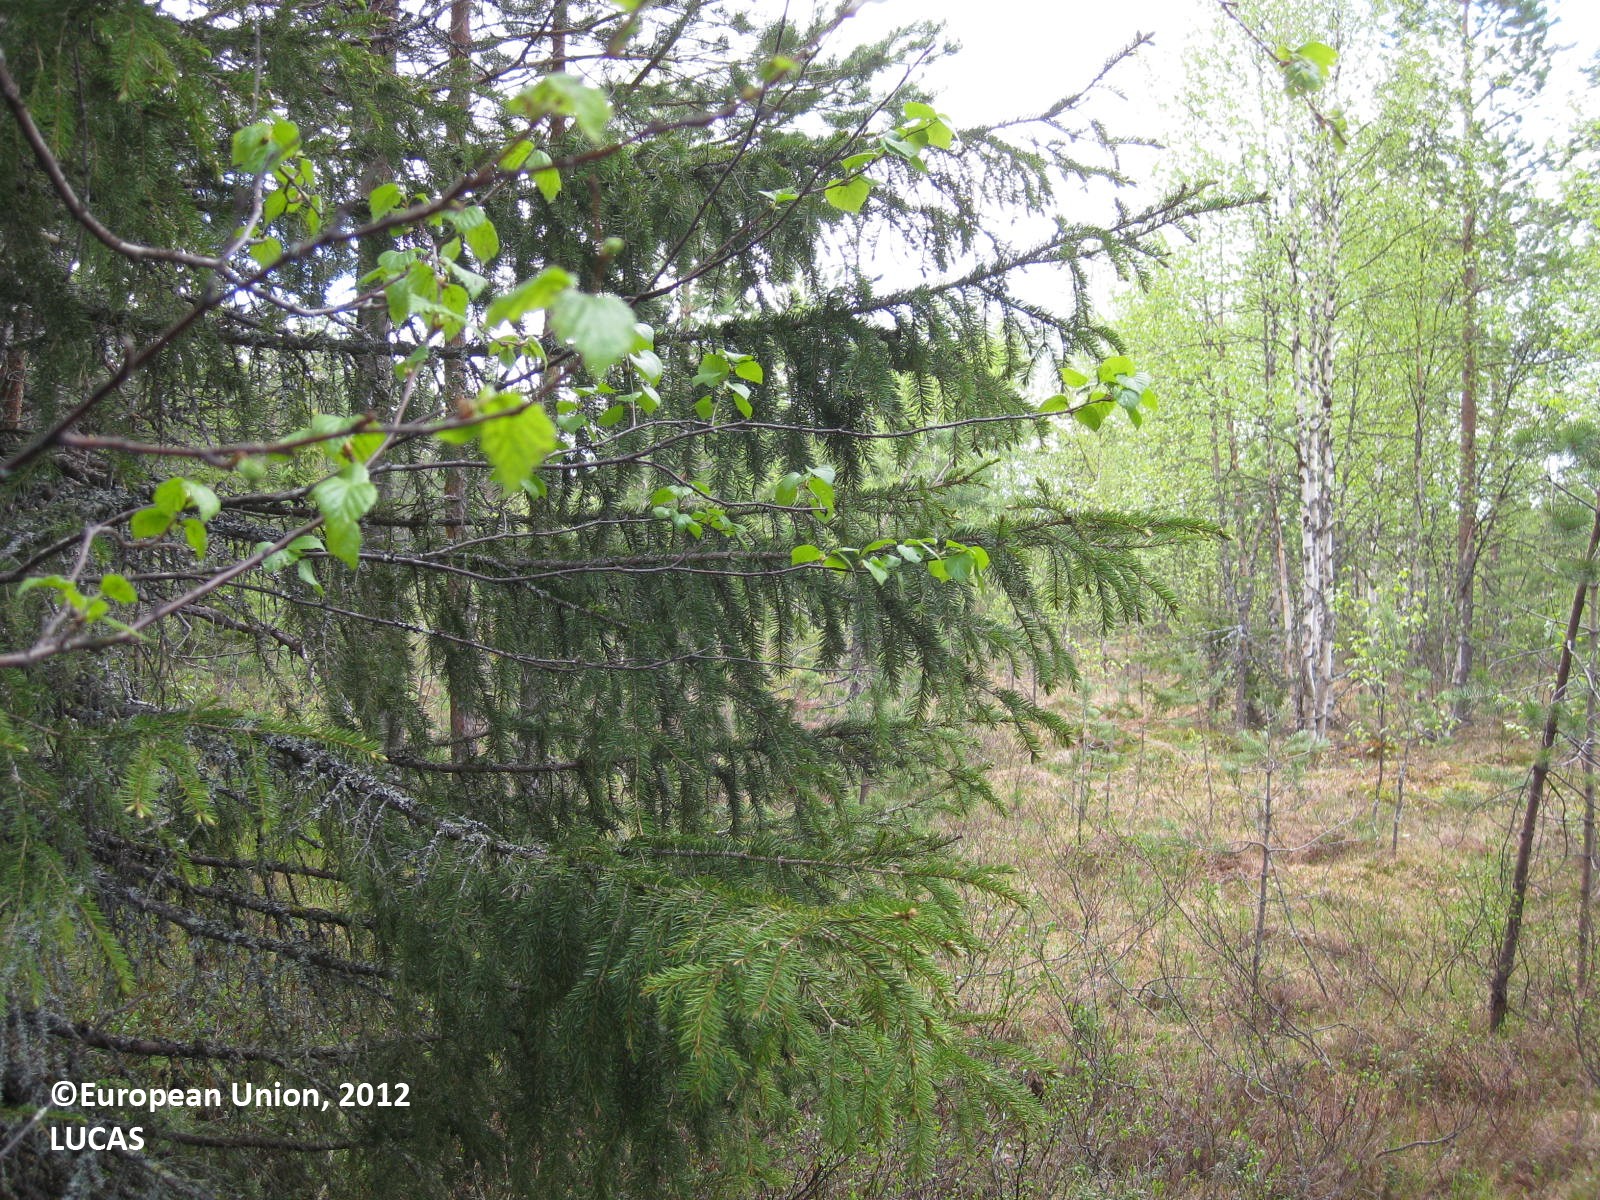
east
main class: Woodland
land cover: Spruce dominated mixed woodland
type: boreal forest
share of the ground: 50 - 75 %
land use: Forestry
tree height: > 5 m
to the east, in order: Spruce dominated mixed woodland; Pine dominated mixed woodland; Ditches and canals; Pine dominated mixed woodland; Peatbogs; Broadleaved woodland; Peatbogs
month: June
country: FI
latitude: 65.0540
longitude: 29.5662
